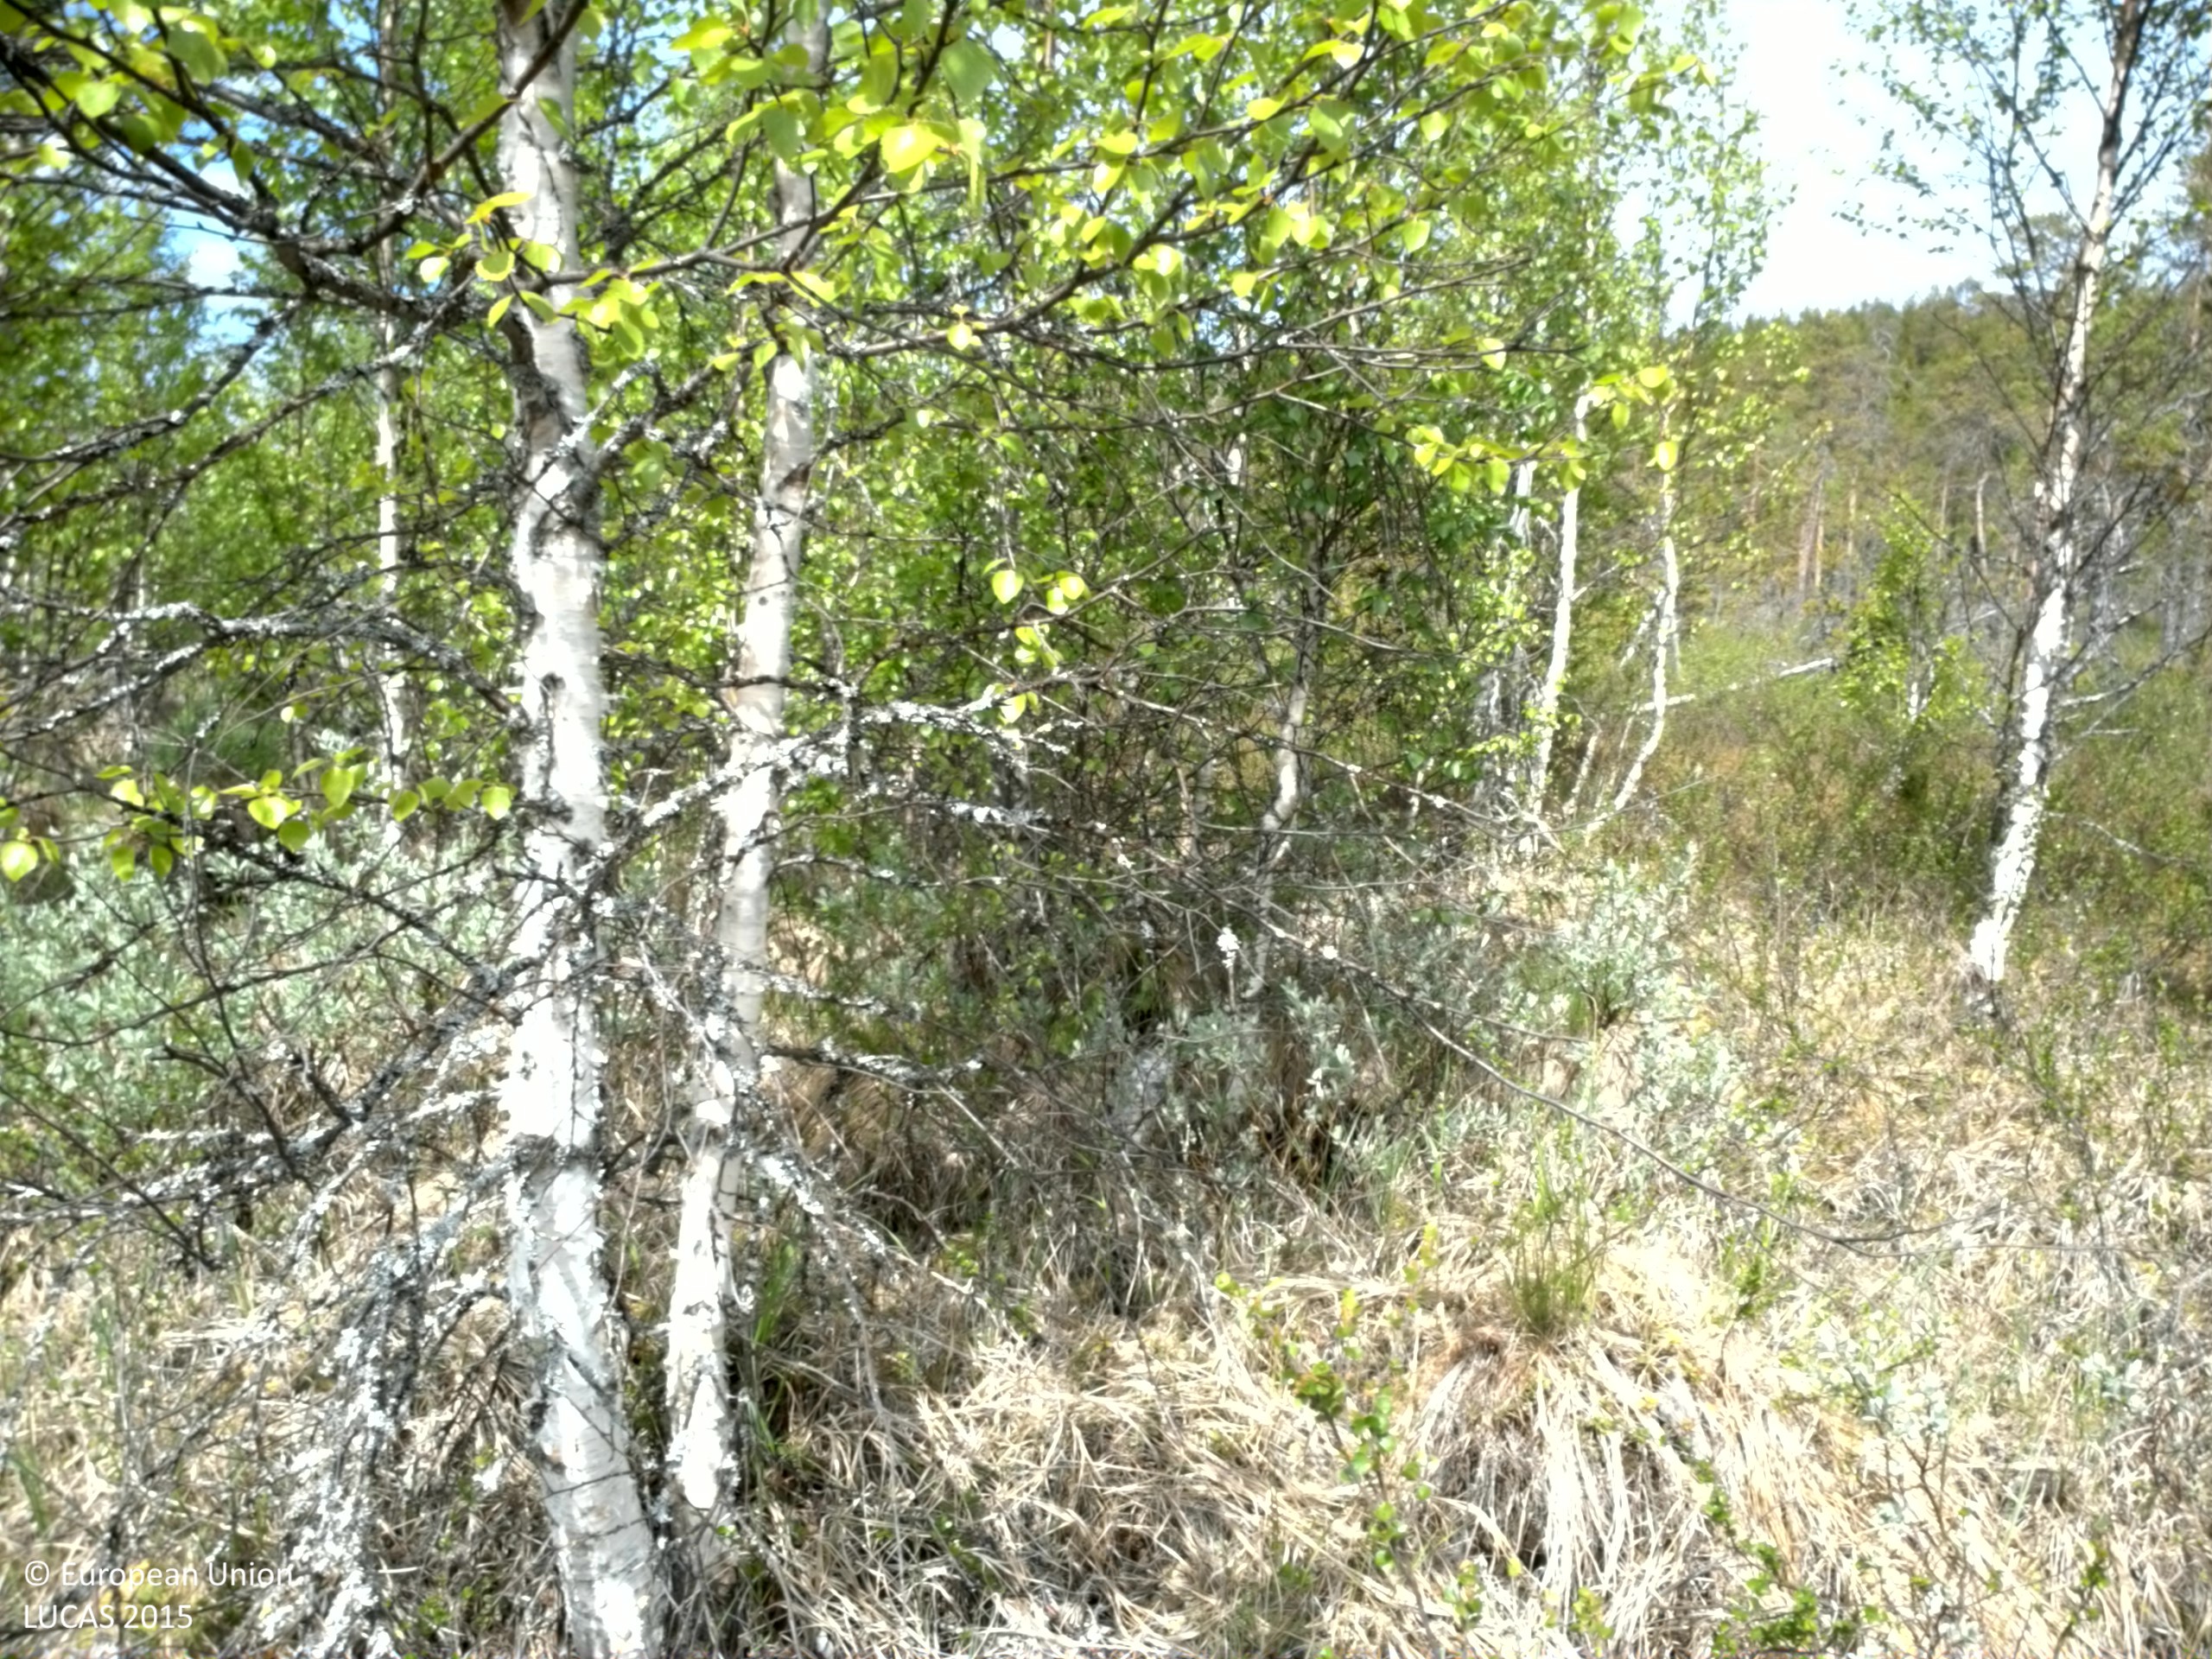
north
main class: Woodland
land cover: Pine dominated coniferous woodland
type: boreal forest
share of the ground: 25 - 50 %
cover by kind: coniferous forest trees 50 %, shrubs 30 %, herbaceous plants 20 %
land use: Forestry
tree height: > 5 m
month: June
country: SE
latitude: 63.2024
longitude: 17.9092
